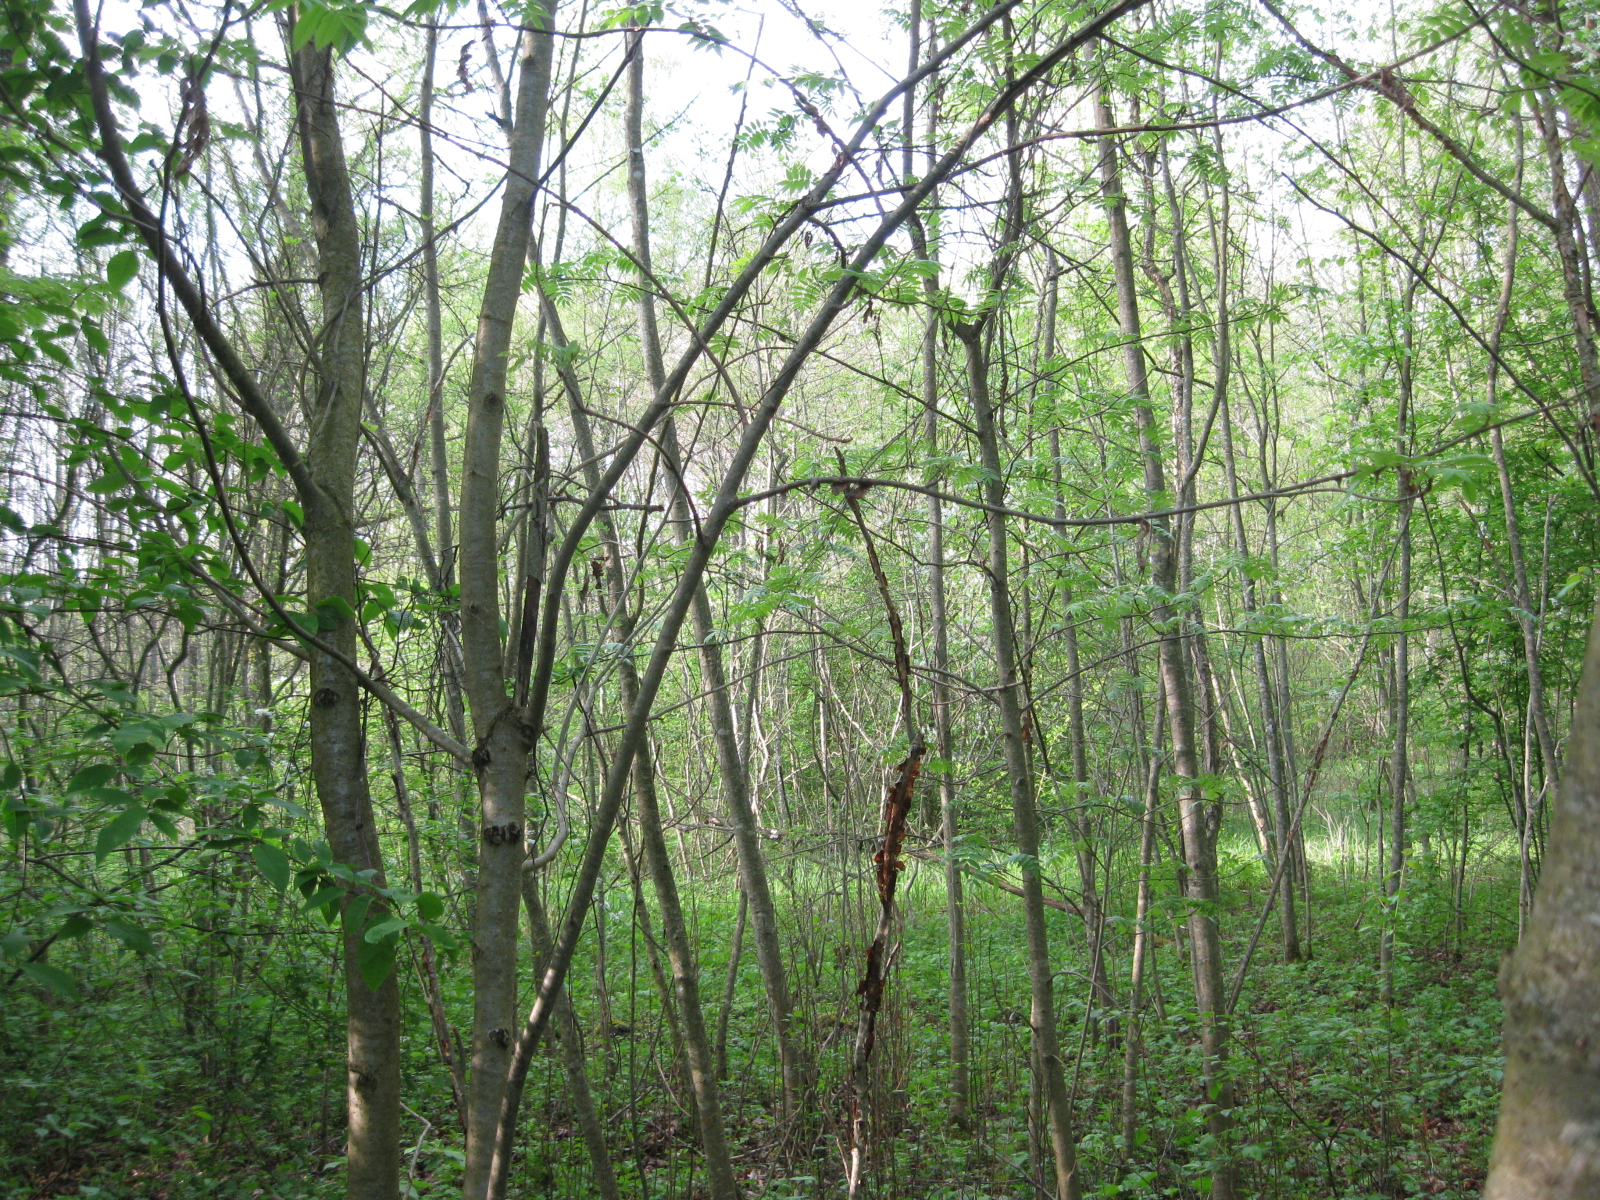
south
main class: Woodland
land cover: Broadleaved woodland
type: non-riverine alder, birch or aspen forest
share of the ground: > 75 %
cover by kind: broadleaved forest trees 90 %, herbaceous plants 10 %
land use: Forestry
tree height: > 5 m
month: May
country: LT
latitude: 56.2397
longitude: 24.4727
